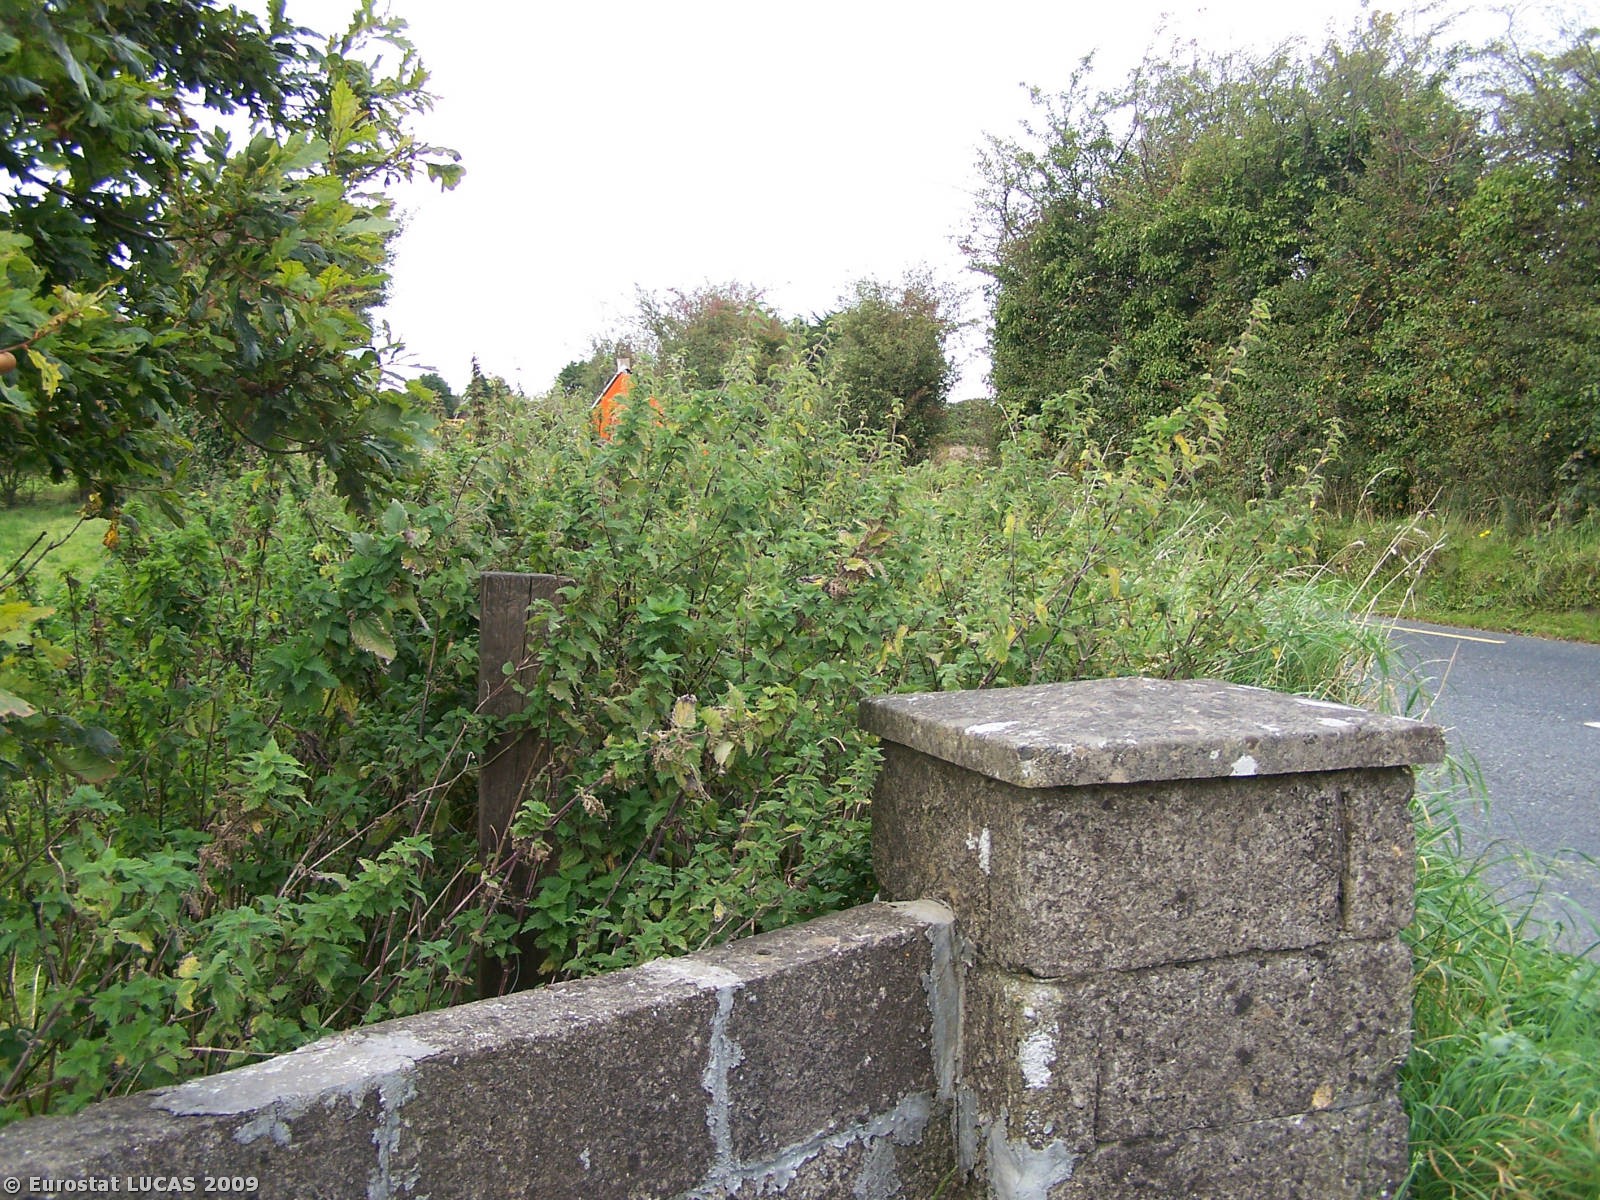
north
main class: Grassland
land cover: Grassland without tree/shrub cover
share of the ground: > 75 %
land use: Agriculture (excluding fallow land and kitchen gardens)
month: September
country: IE
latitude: 52.4027
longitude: -8.3711
